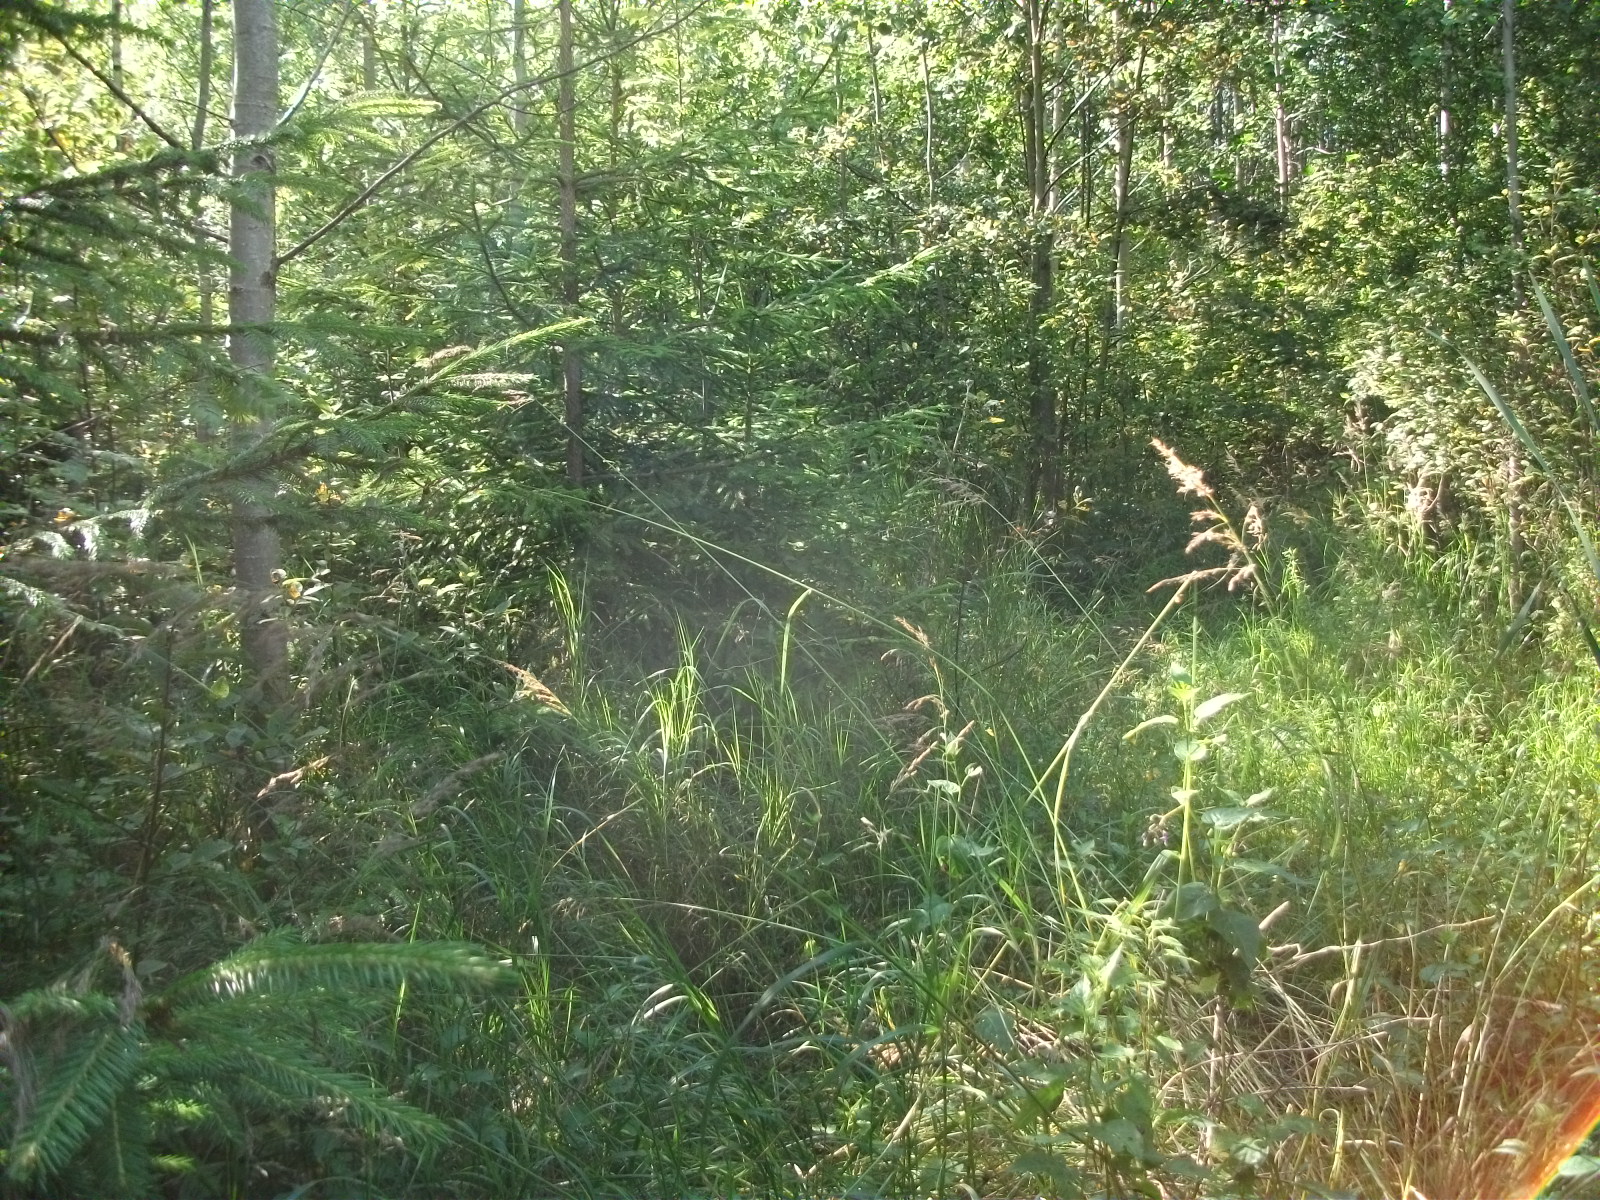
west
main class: Woodland
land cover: Broadleaved woodland
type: non-riverine alder, birch or aspen forest
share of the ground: > 75 %
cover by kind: broadleaved forest trees 85 %, coniferous forest trees 5 %, shrubs 5 %, herbaceous plants 5 %
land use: Forestry
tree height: > 5 m
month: August
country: LV
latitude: 57.0664
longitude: 26.5903
